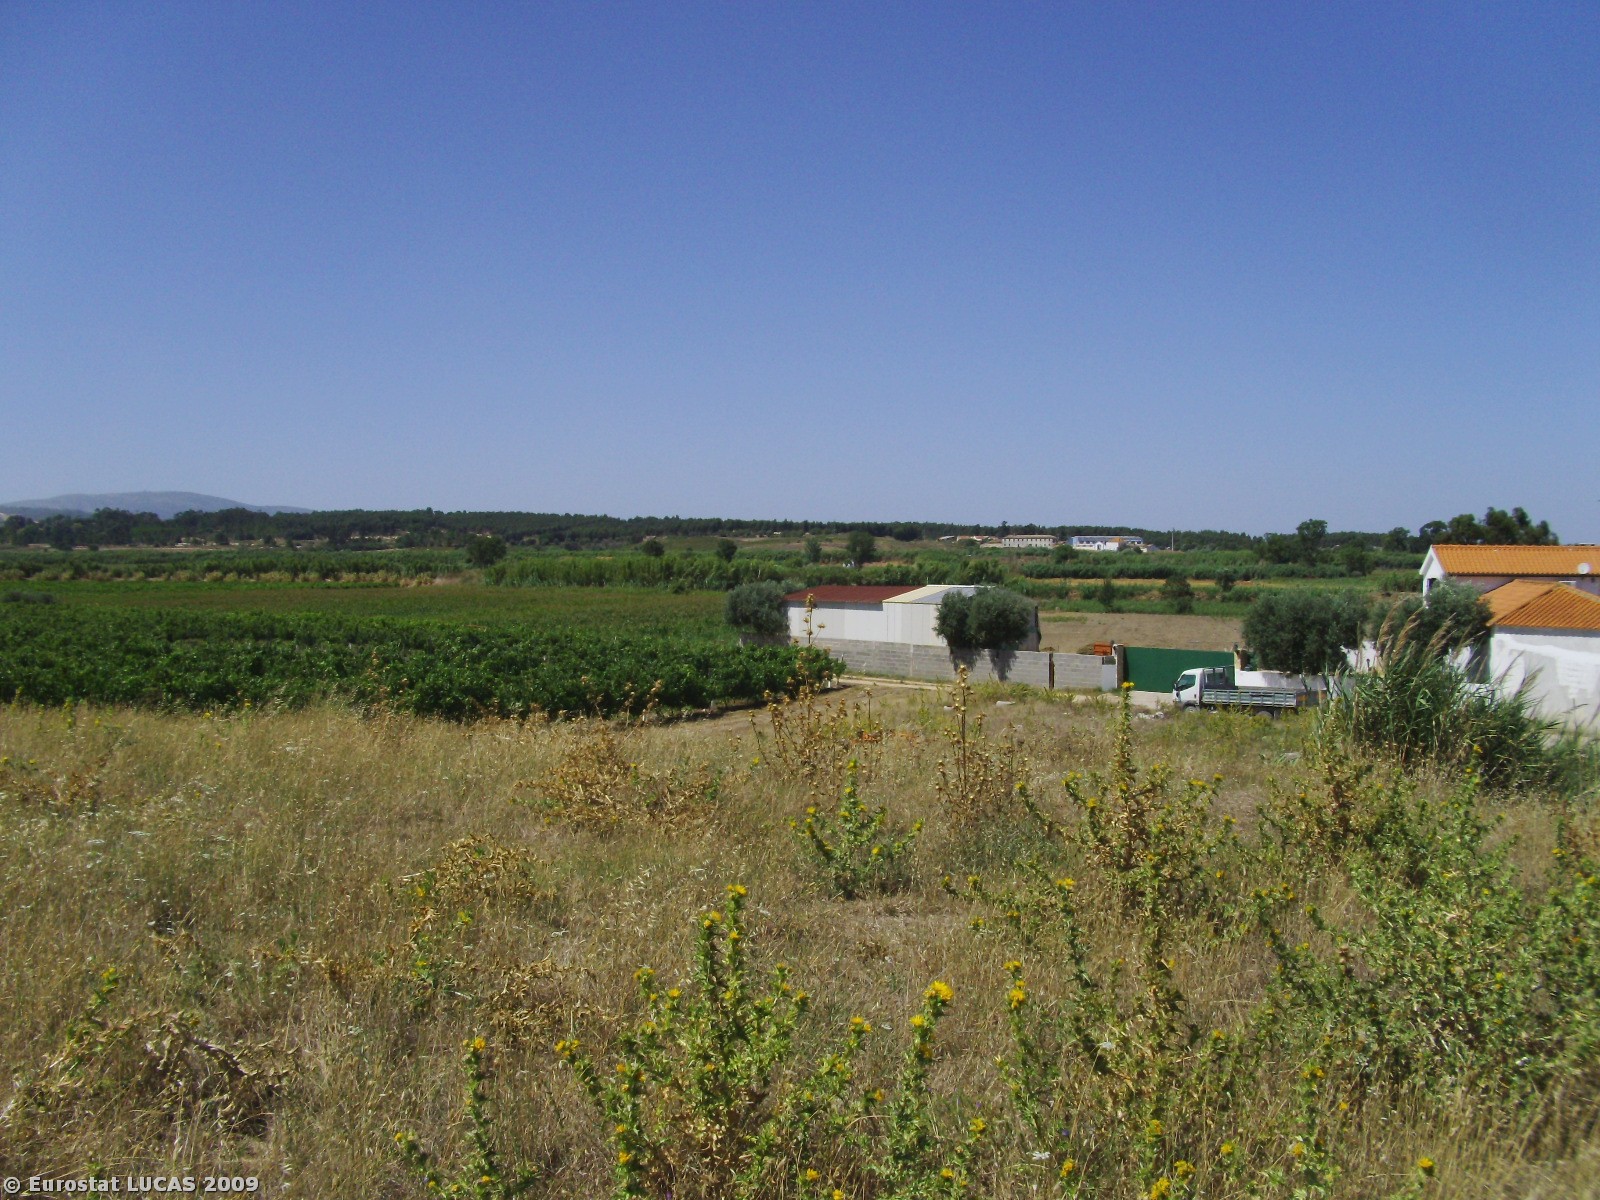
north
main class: Grassland
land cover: Spontaneously vegetated surfaces
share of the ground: > 75 %
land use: Unused
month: July
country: PT
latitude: 39.0461
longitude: -8.9679
